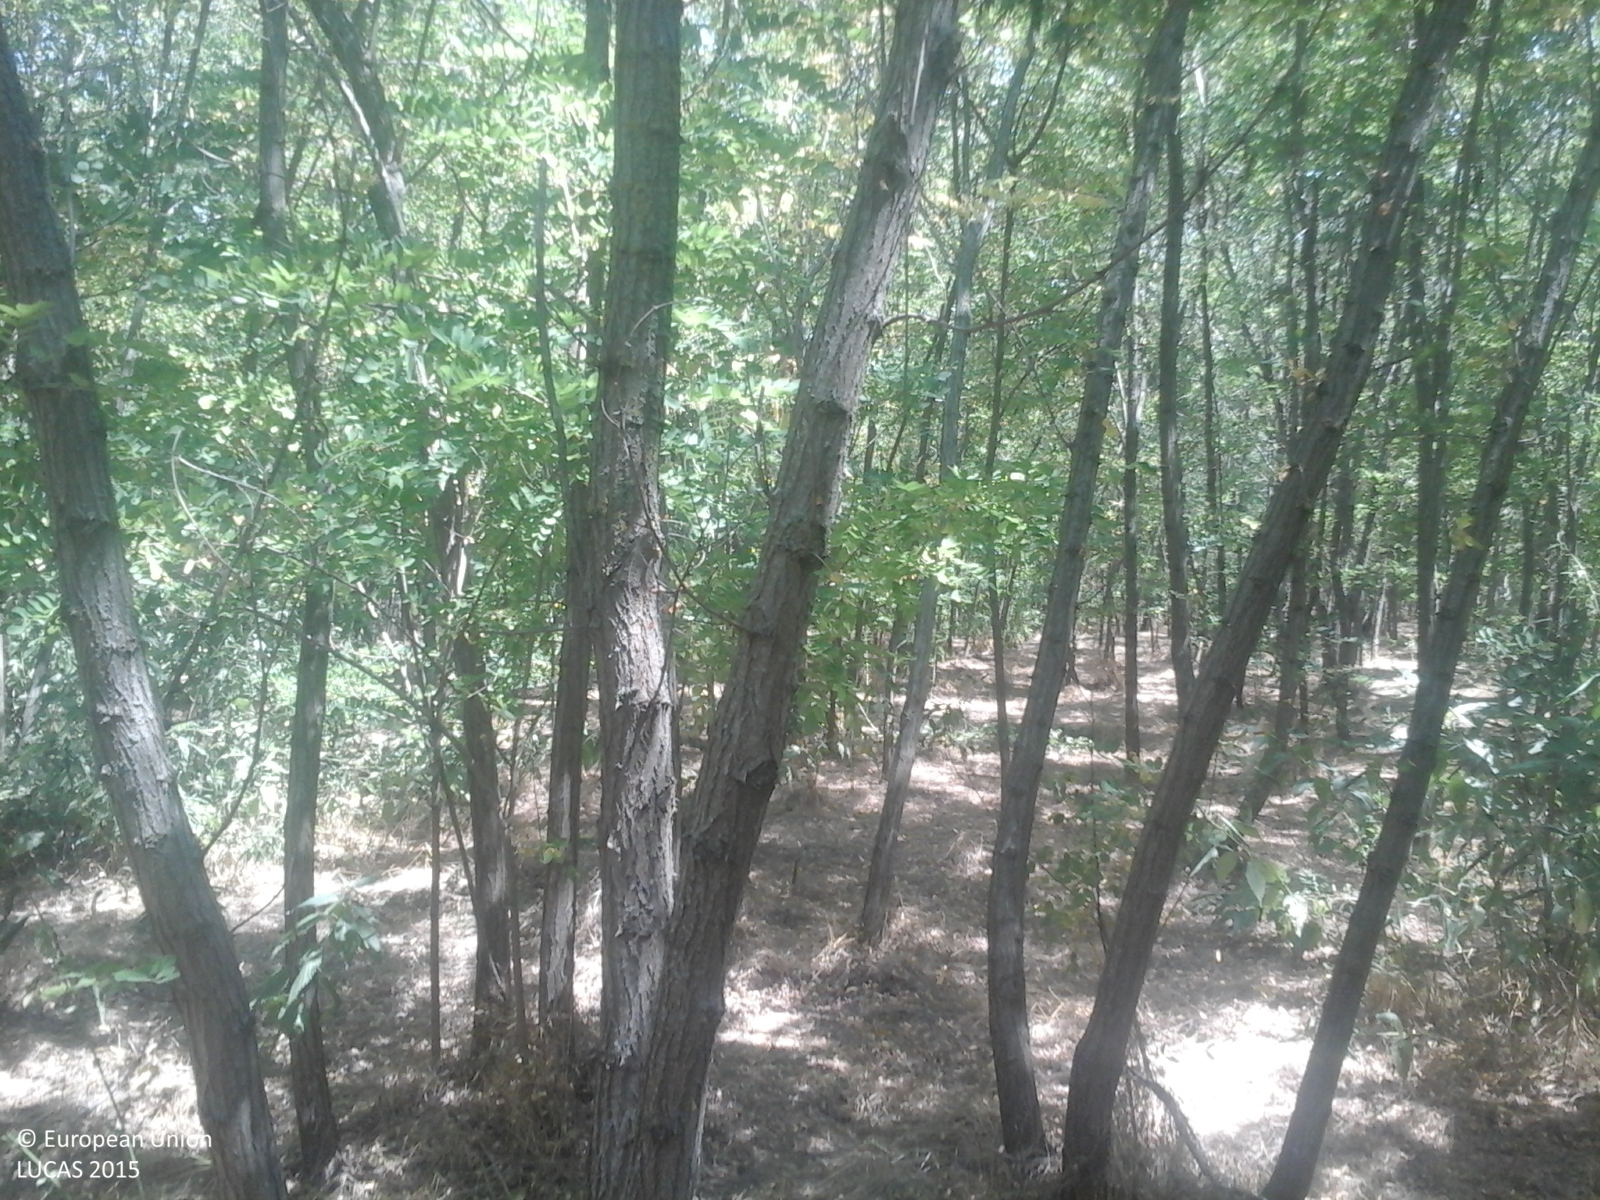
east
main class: Woodland
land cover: Broadleaved woodland
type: exotic forest
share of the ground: > 75 %
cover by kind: broadleaved forest trees 100 %
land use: Forestry
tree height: > 5 m
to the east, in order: Broadleaved woodland
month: July
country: RO
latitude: 44.8673
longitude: 27.6558
